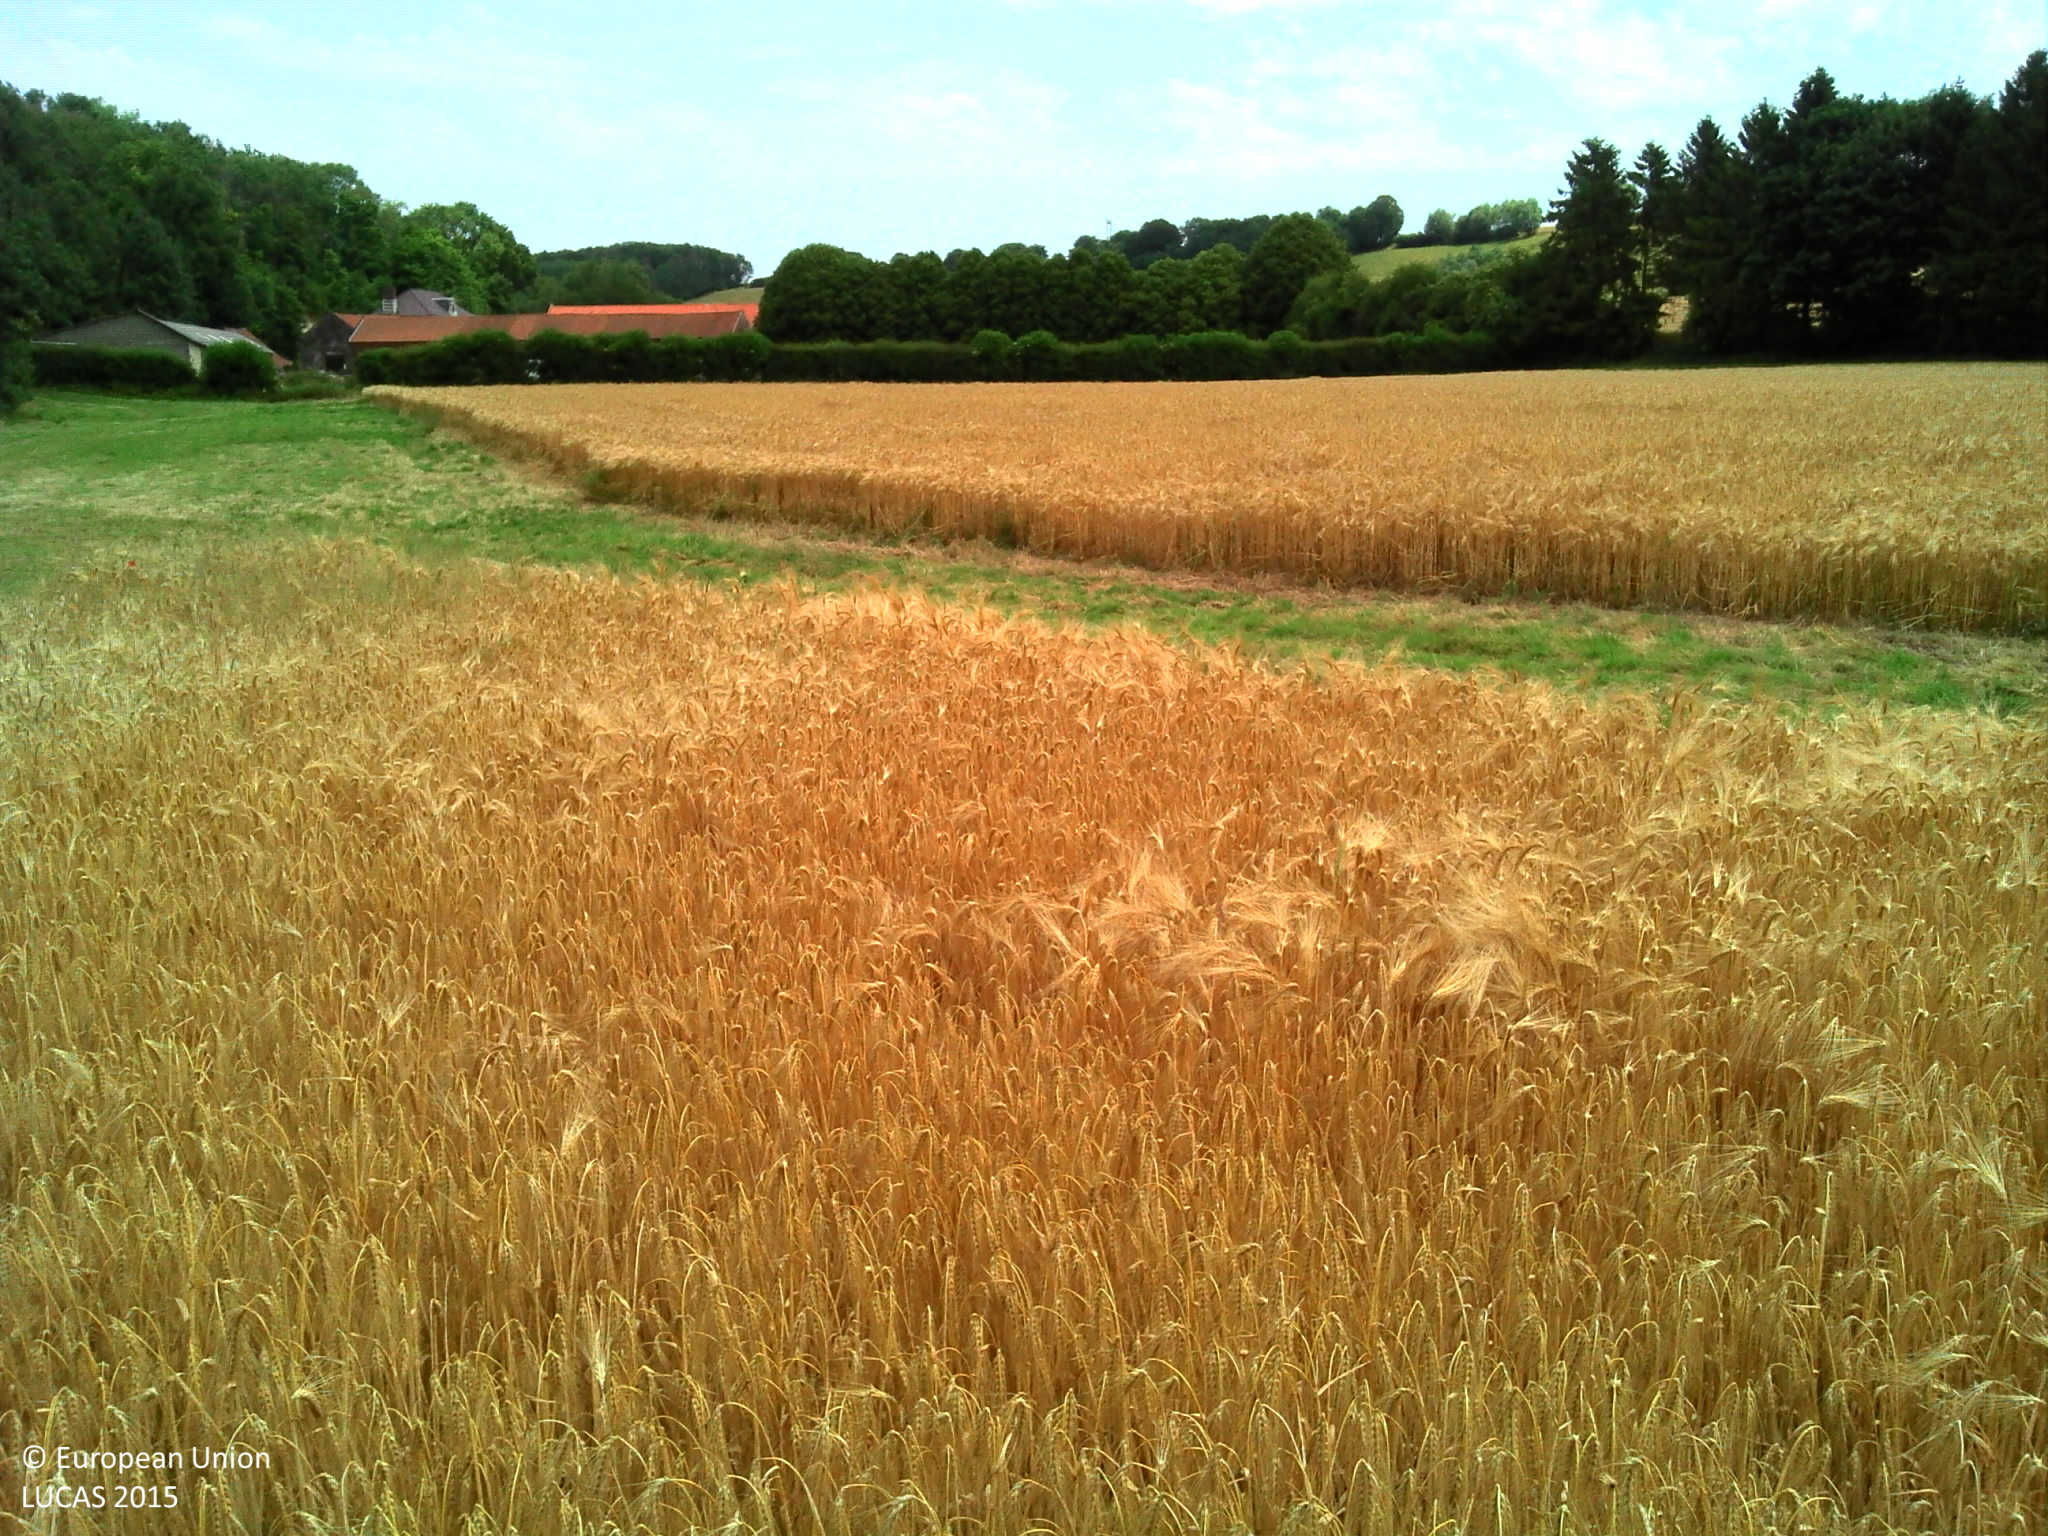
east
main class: Cropland
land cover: Barley
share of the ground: > 75 %
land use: Agriculture (excluding fallow land and kitchen gardens)
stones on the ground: < 10 %
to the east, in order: Barley; Grass margins; Ditches and canals; Grassland without tree/shrub cover; Barley; Managed hedges; Grassland without tree/shrub cover; Broadleaved woodland; Grassland without tree/shrub cover
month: July
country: FR
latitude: 50.4170
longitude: 2.1179
